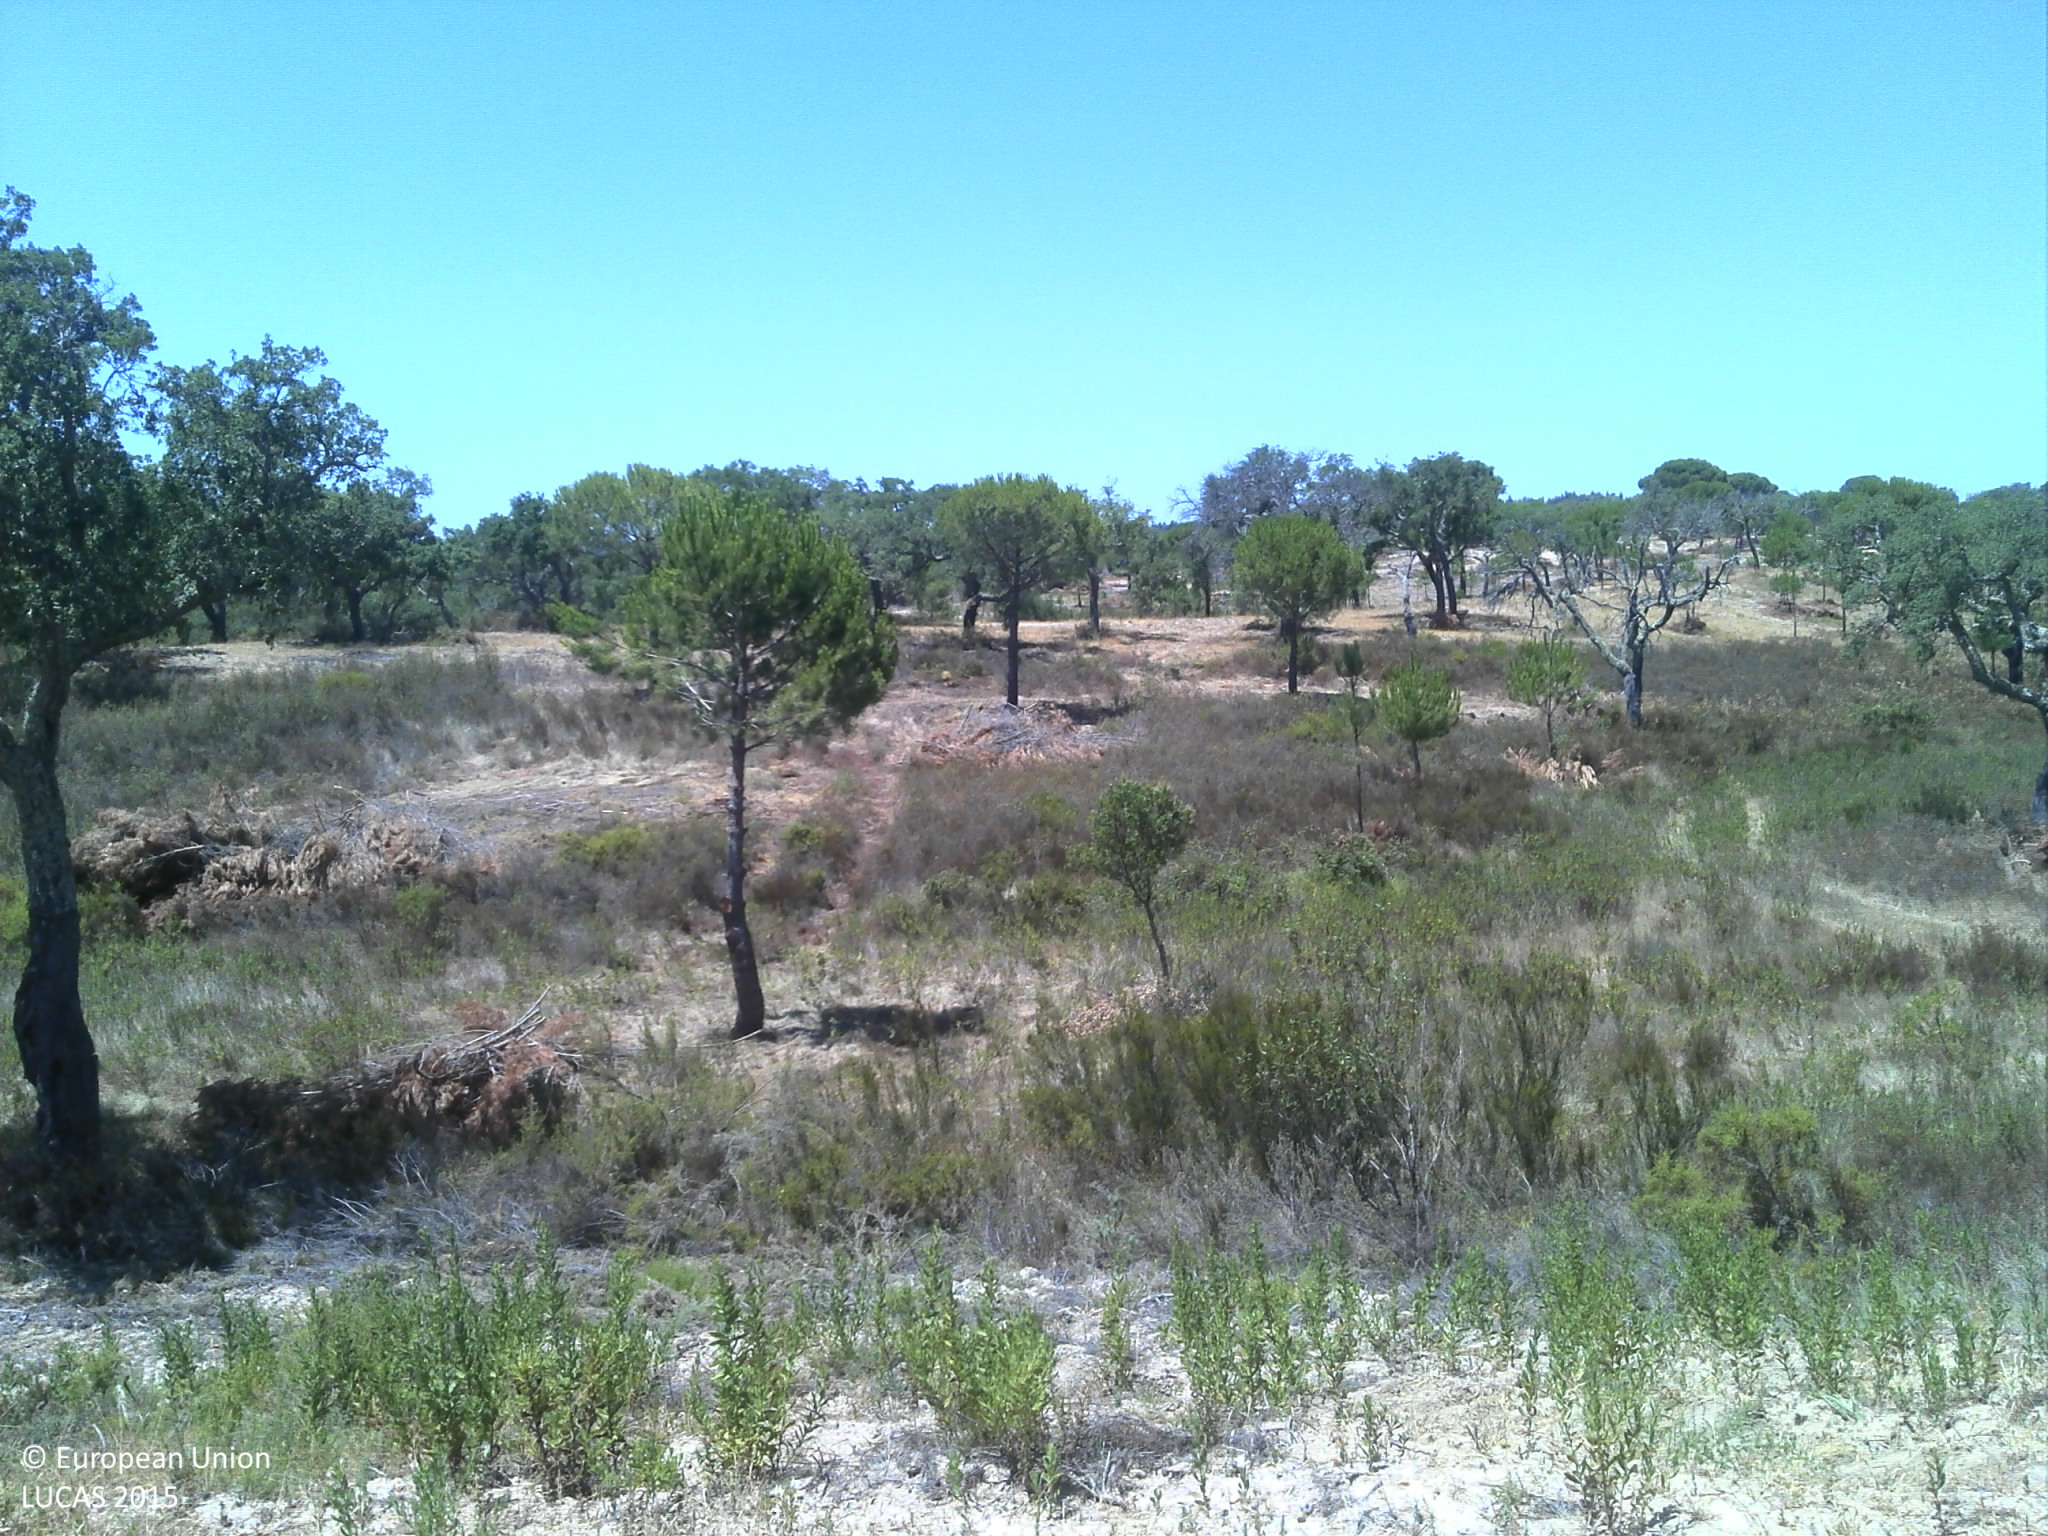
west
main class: Woodland
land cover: Broadleaved woodland
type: broadleaved evergreen forest
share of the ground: 25 - 50 %
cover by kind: unconsolidated bare surface 55 %, broadleaved forest trees 35 %, herbaceous plants 10 %
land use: Forestry
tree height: > 5 m
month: July
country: PT
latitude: 39.0511
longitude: -8.2803
